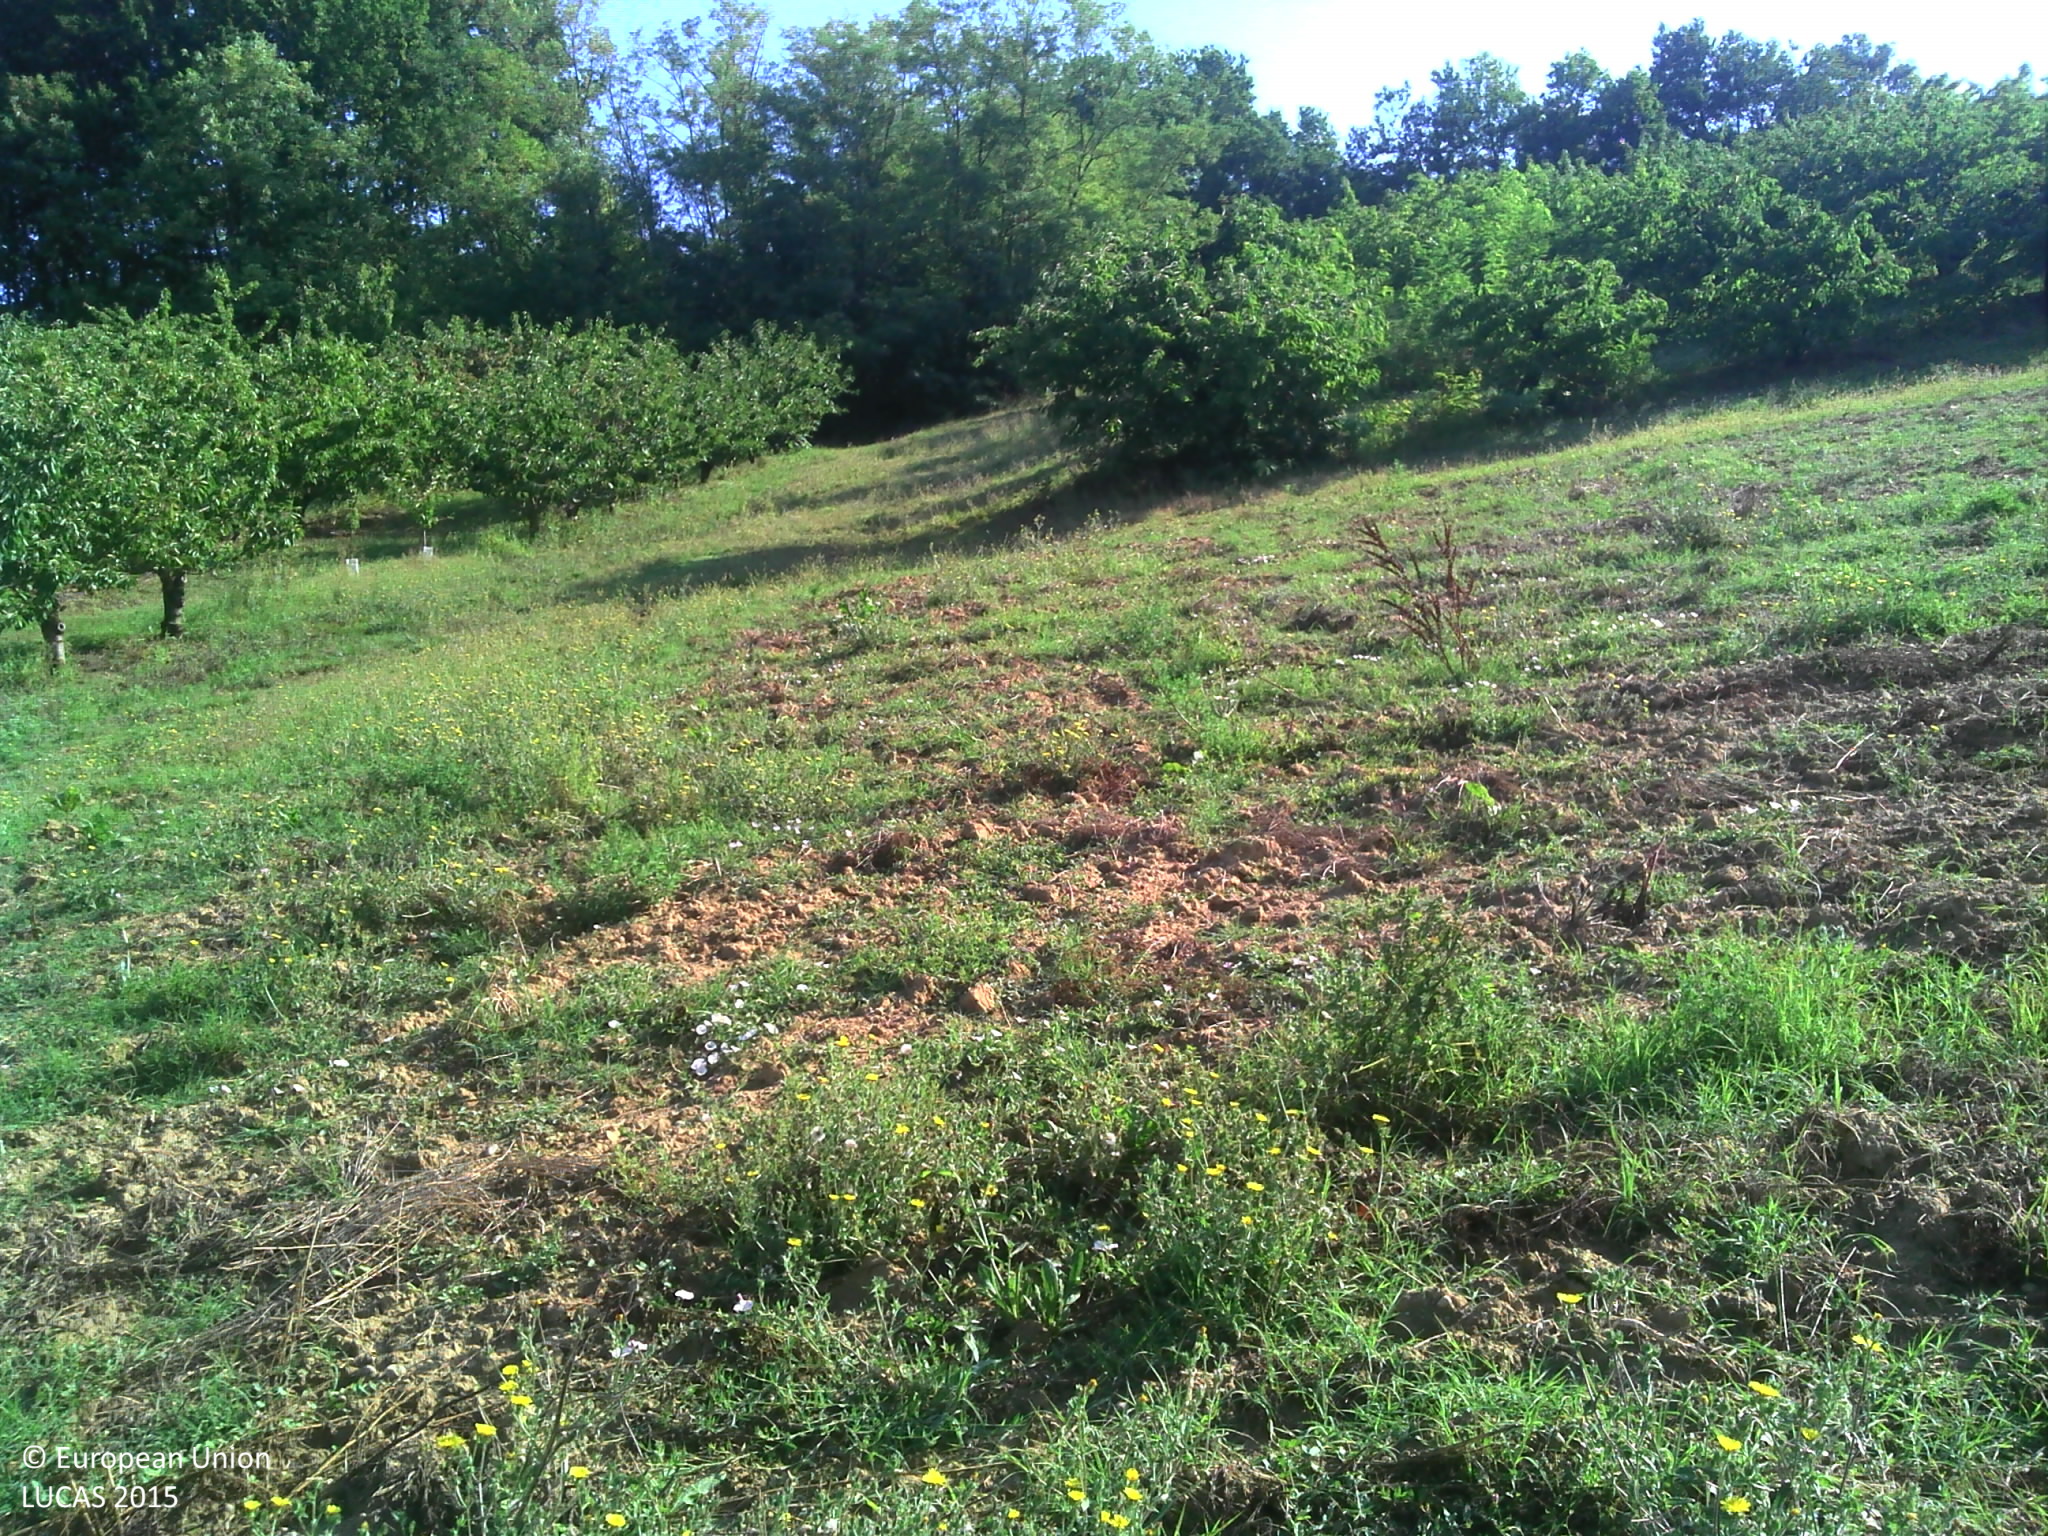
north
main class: Grassland
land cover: Grassland without tree/shrub cover
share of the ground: > 75 %
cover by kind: herbaceous plants 100 %
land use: Agriculture (excluding fallow land and kitchen gardens)
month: August
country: FR
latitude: 44.0970
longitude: 1.3430
